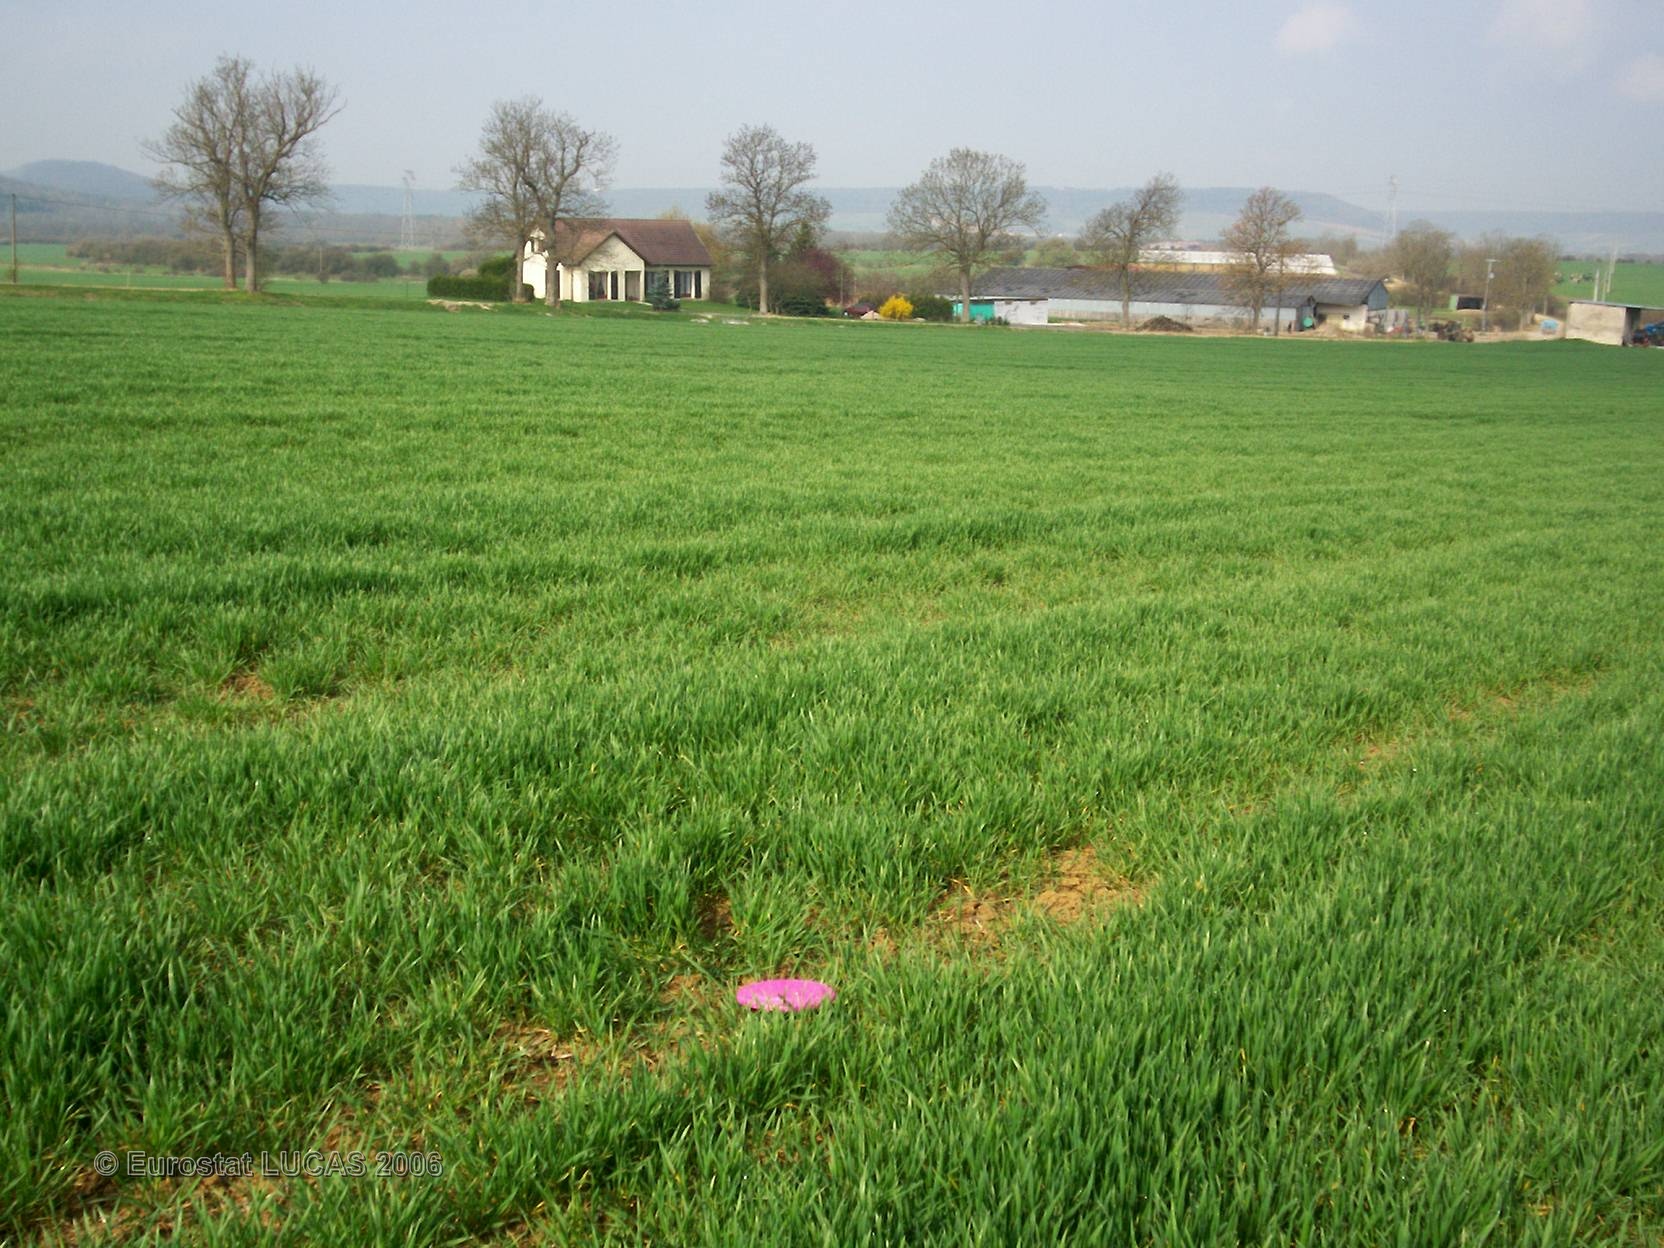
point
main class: Cropland
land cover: Common wheat
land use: Agriculture (excluding fallow land and kitchen gardens)
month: April
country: FR
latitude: 48.7062
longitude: 5.9094
